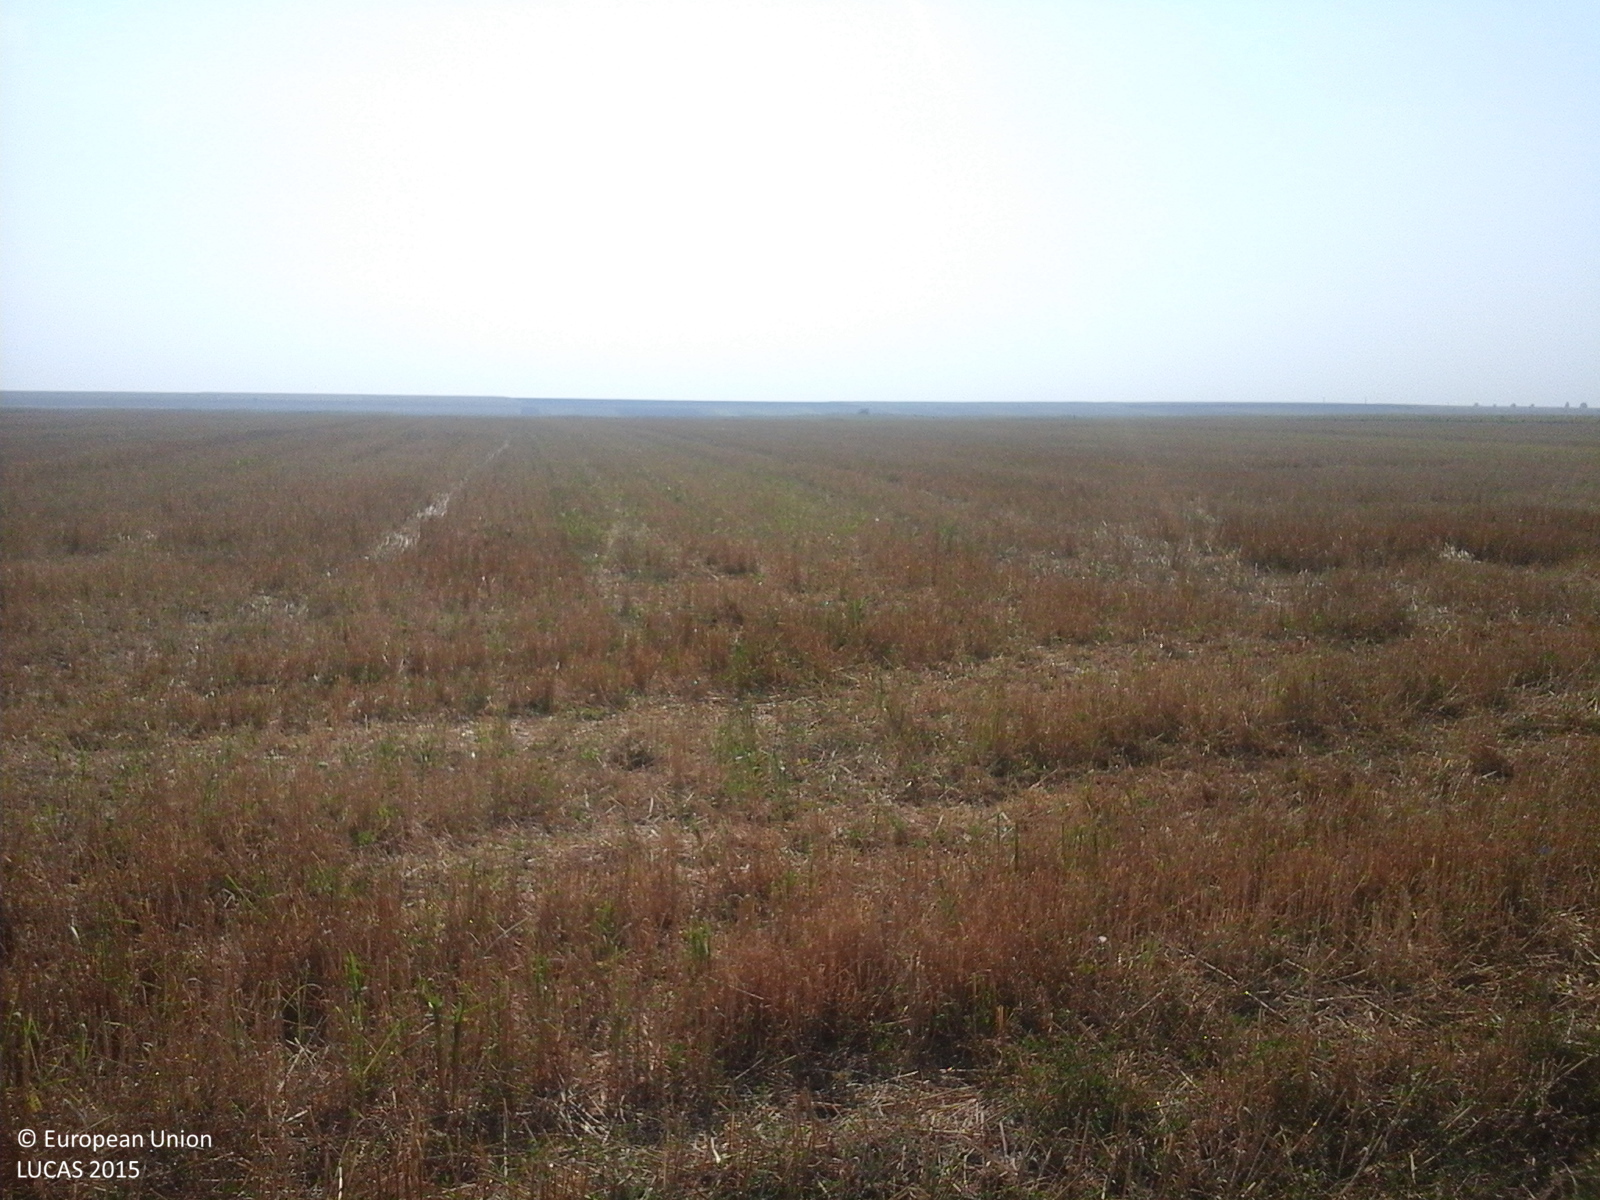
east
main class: Cropland
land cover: Common wheat
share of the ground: > 75 %
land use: Agriculture (excluding fallow land and kitchen gardens)
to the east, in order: Tracks; Shruby margins; Common wheat
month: August
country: RO
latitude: 45.7119
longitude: 27.5637
